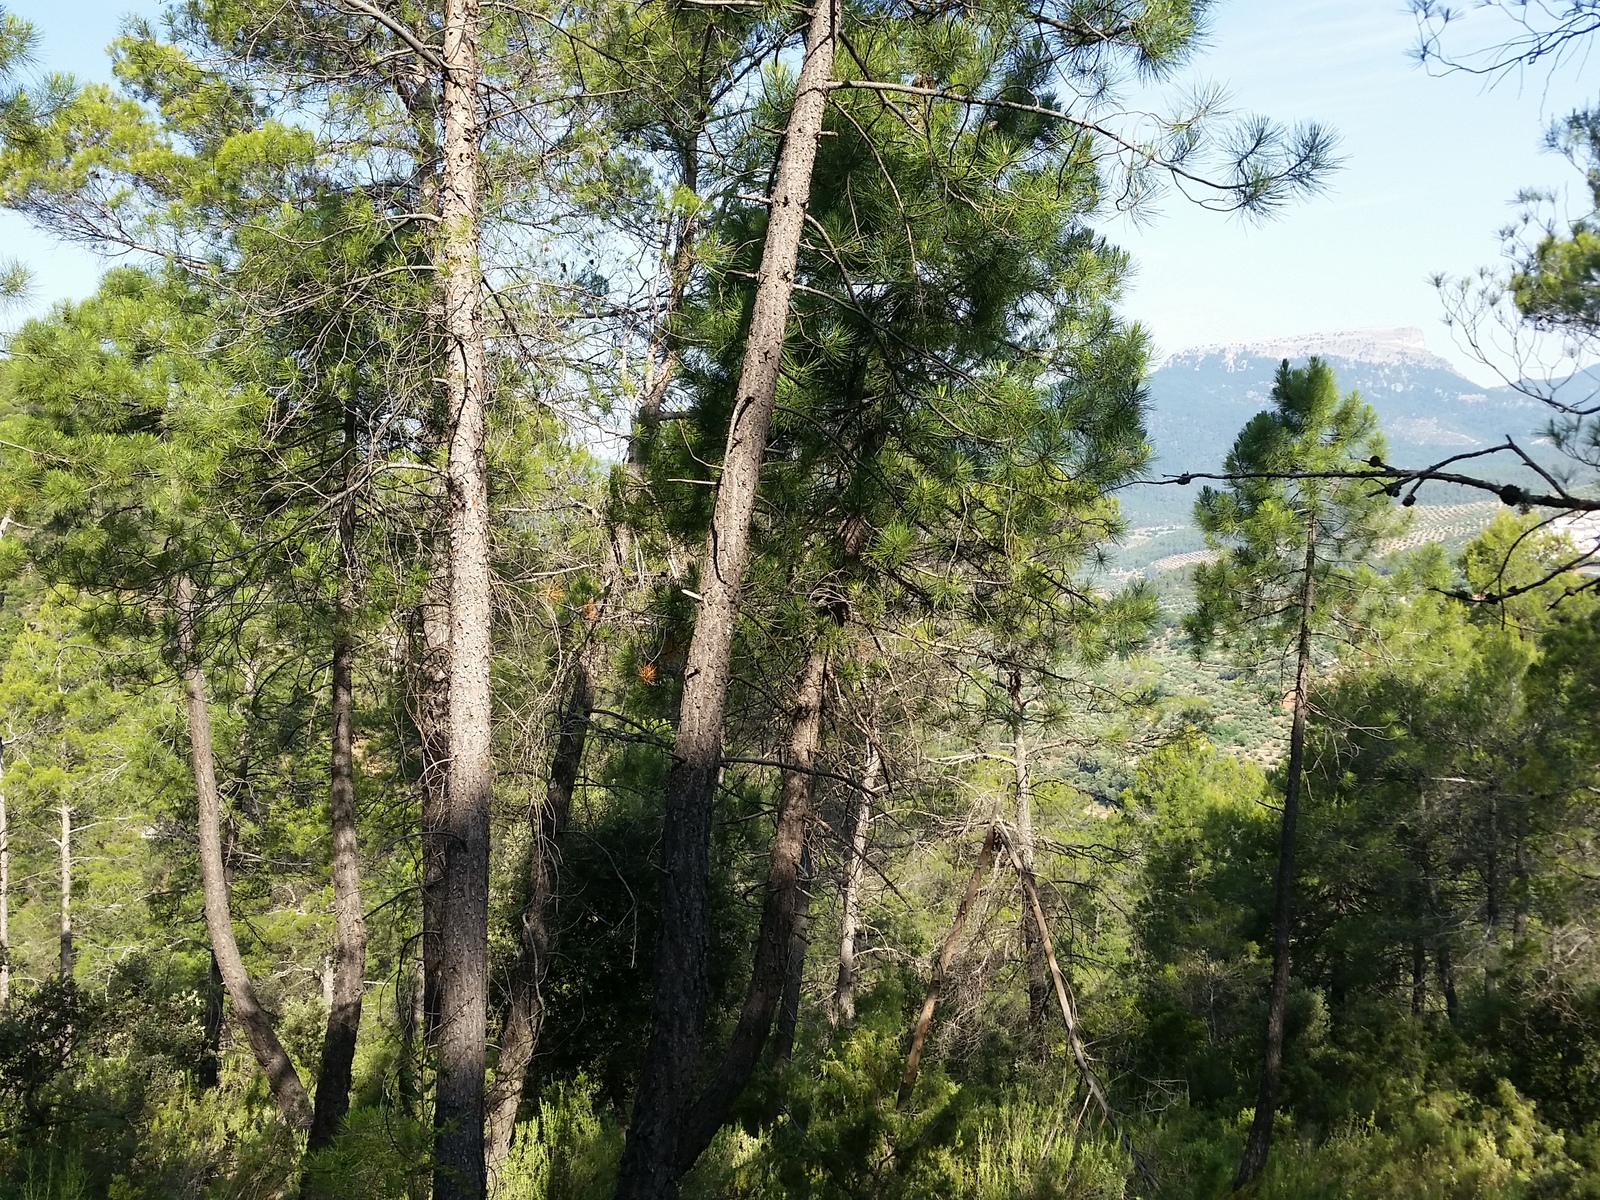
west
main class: Woodland
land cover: Pine dominated coniferous woodland
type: coniferous forest of the mediterranean region
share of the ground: > 75 %
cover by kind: coniferous forest trees 80 %, shrubs 15 %, herbaceous plants 5 %
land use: Forestry
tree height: > 5 m
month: June
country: ES
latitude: 38.4222
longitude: -2.4943
